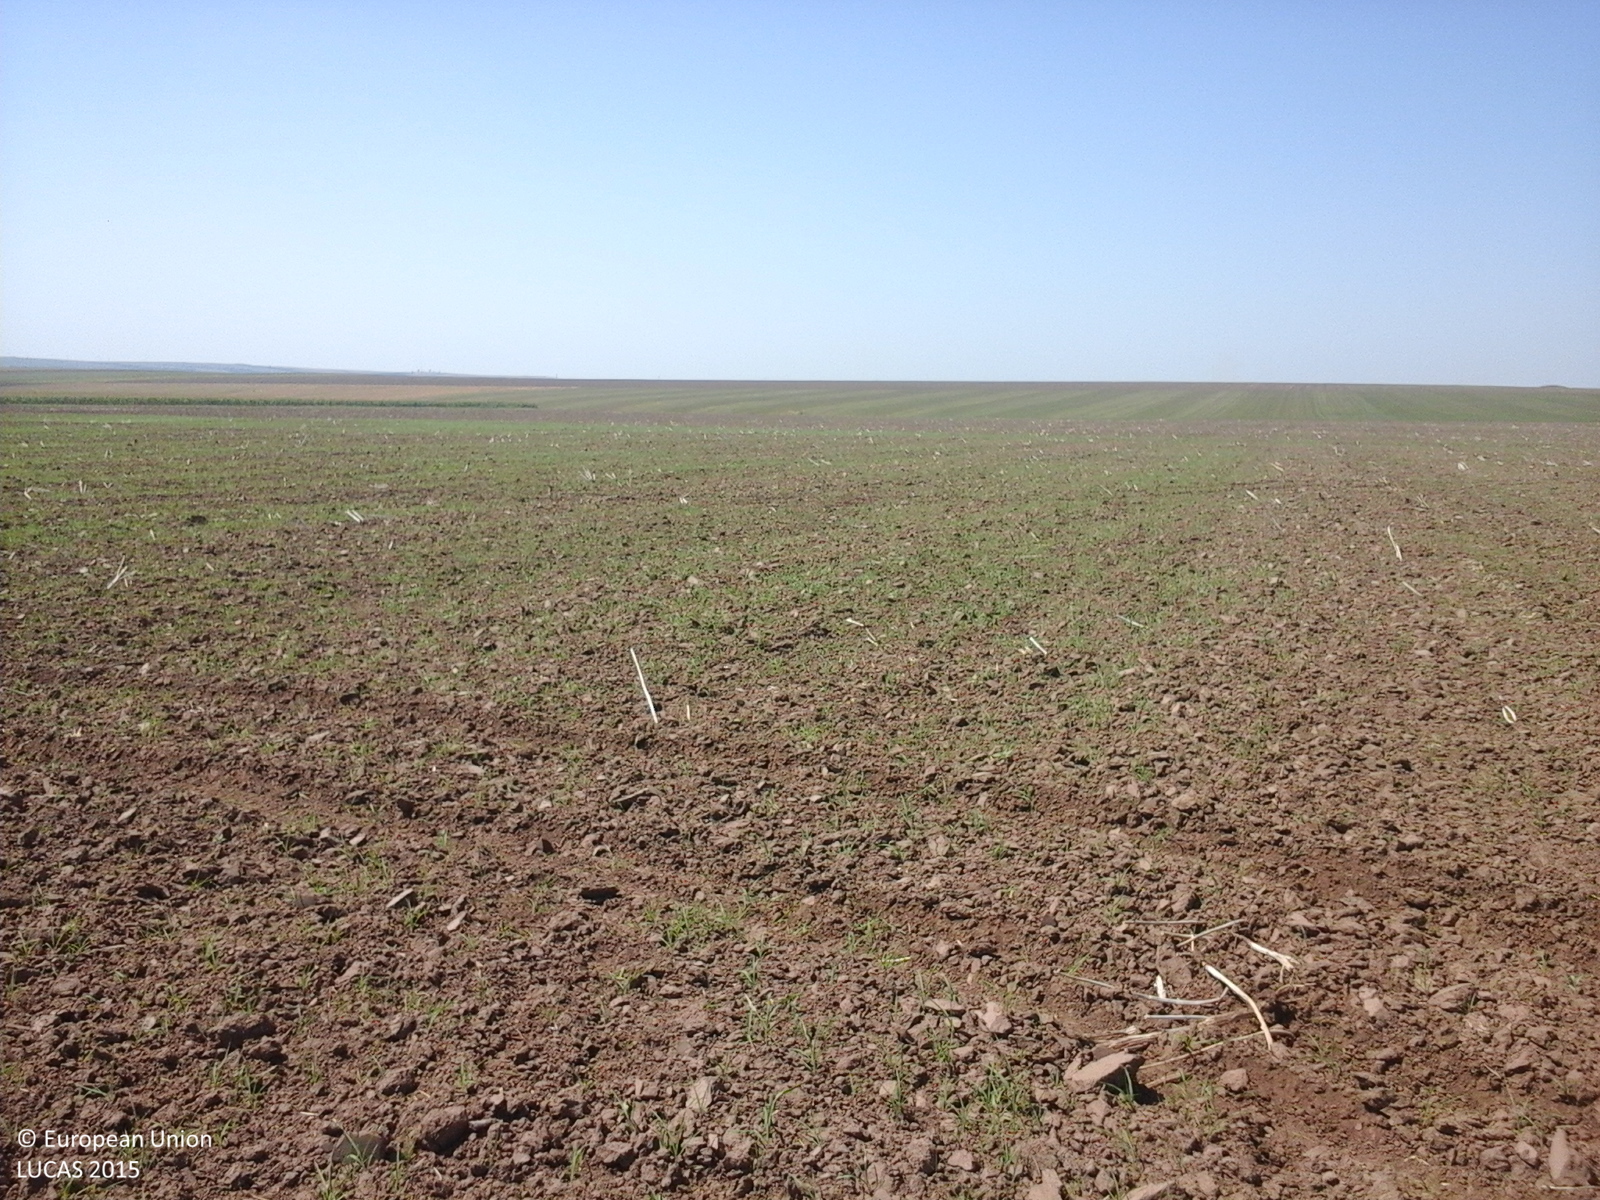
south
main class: Cropland
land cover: Rape and turnip rape
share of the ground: < 10 %
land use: Agriculture (excluding fallow land and kitchen gardens)
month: August
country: RO
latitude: 44.6595
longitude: 28.1091
